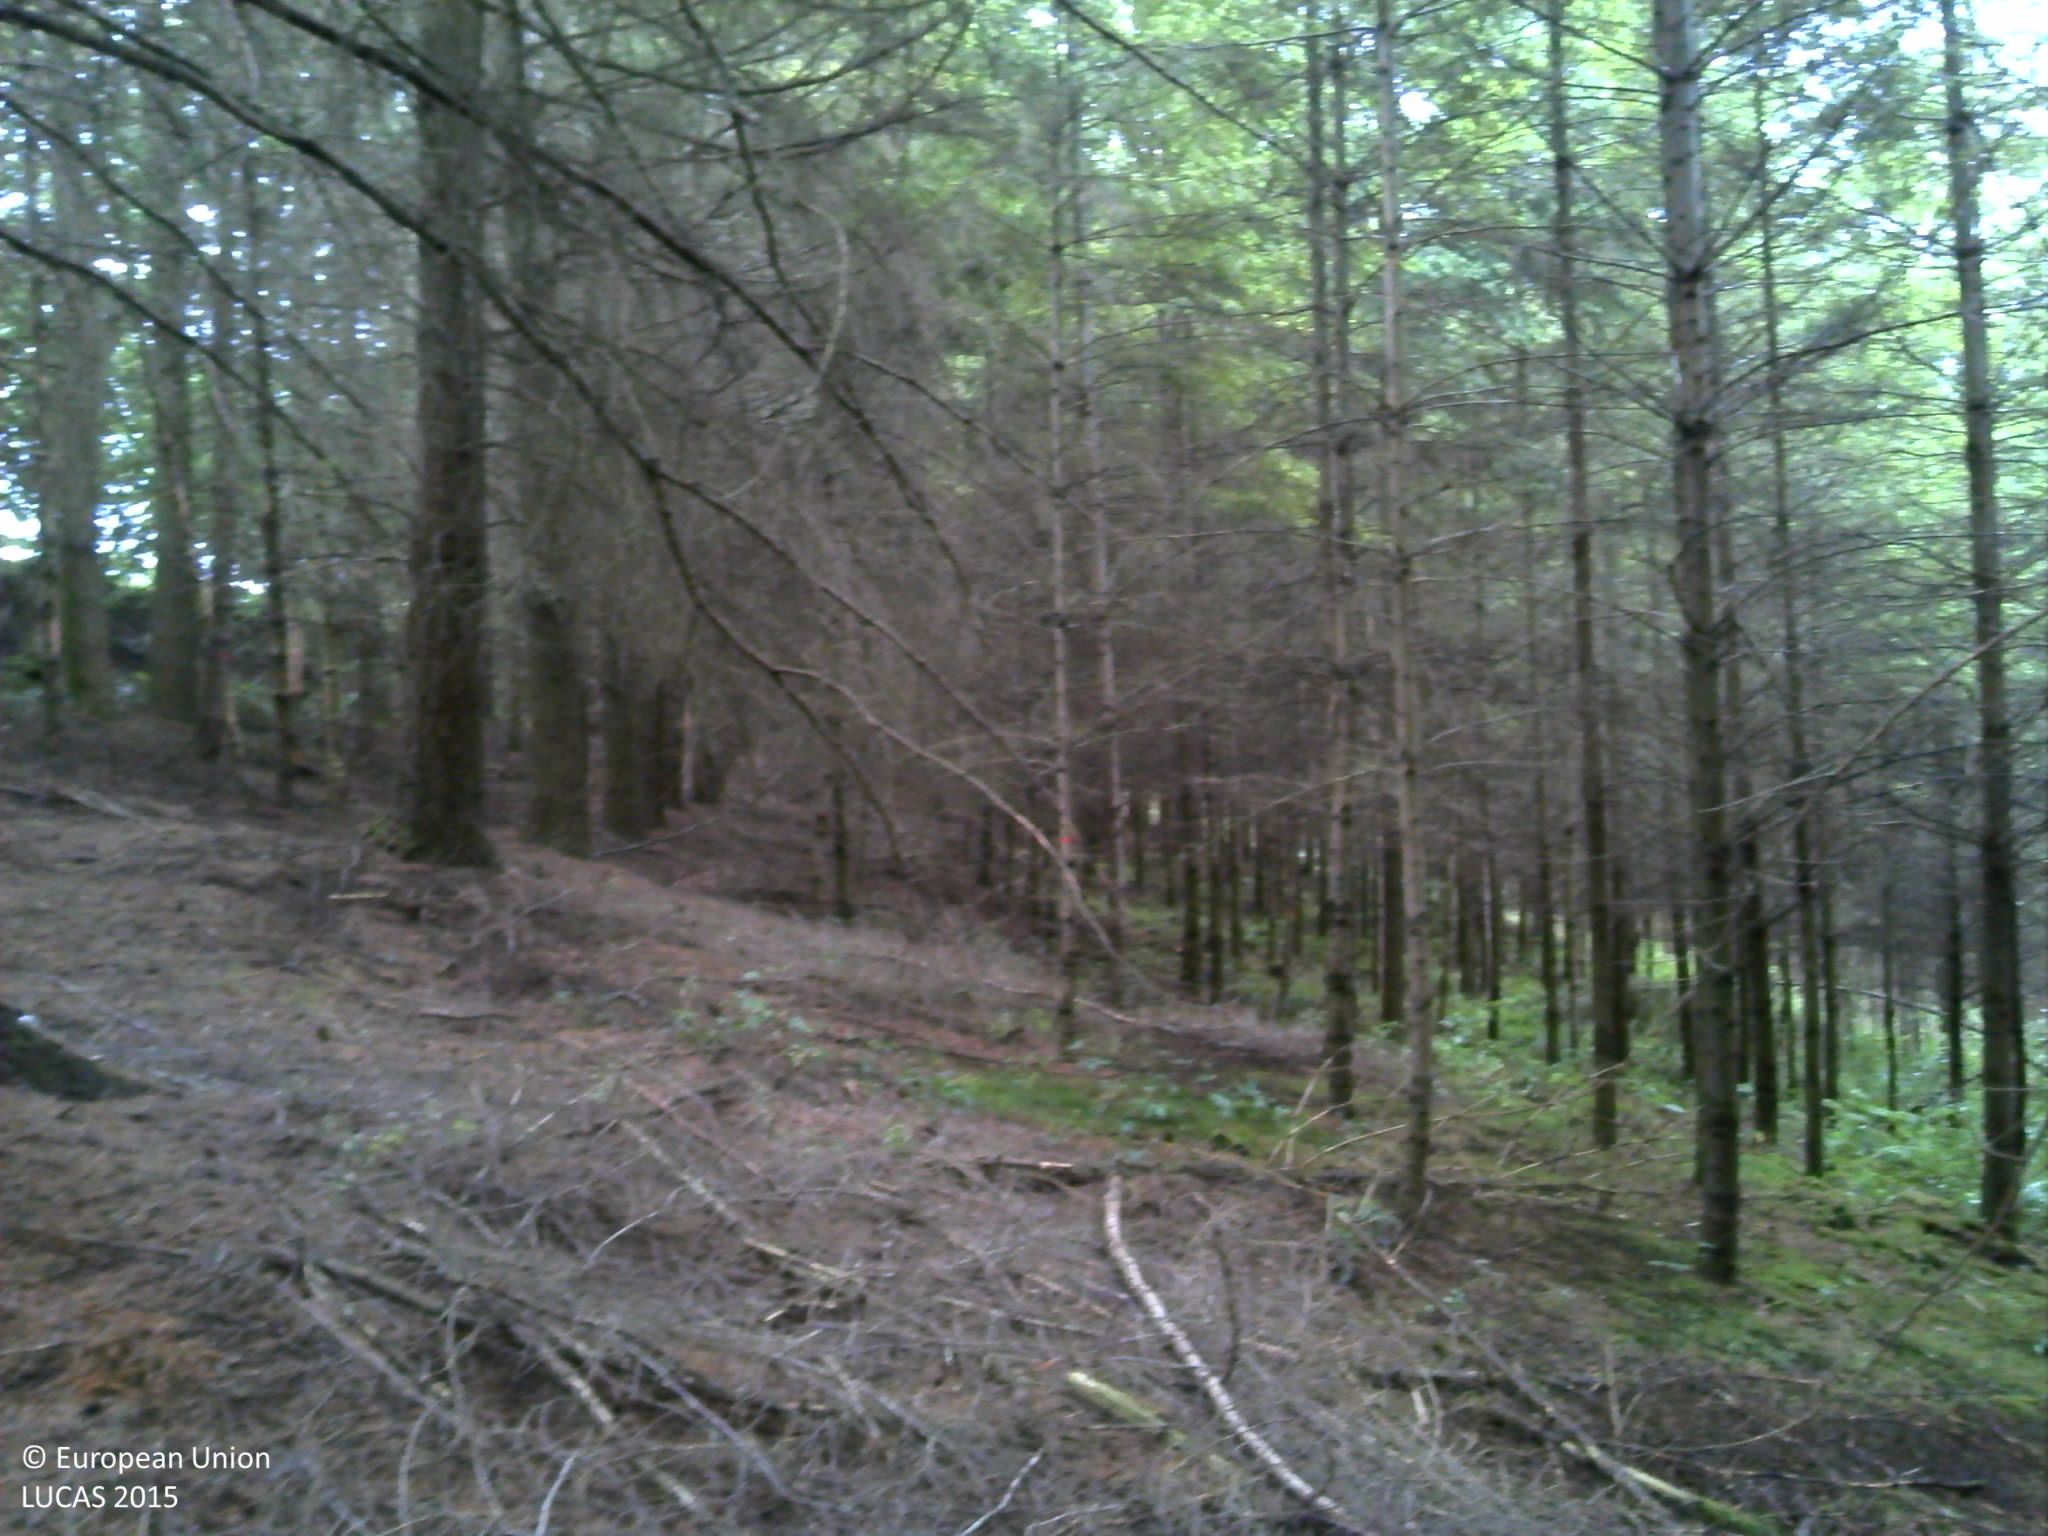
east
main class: Woodland
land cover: Spruce dominated coniferous woodland
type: alpine coniferous forest
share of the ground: > 75 %
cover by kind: coniferous forest trees 80 %, consolidated bare surface 15 %, lichens and mosses 5 %
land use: Forestry
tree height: > 5 m
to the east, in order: Spruce dominated coniferous woodland; Tracks; Spruce dominated coniferous woodland
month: July
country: FR
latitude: 49.7960
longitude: 4.8151
